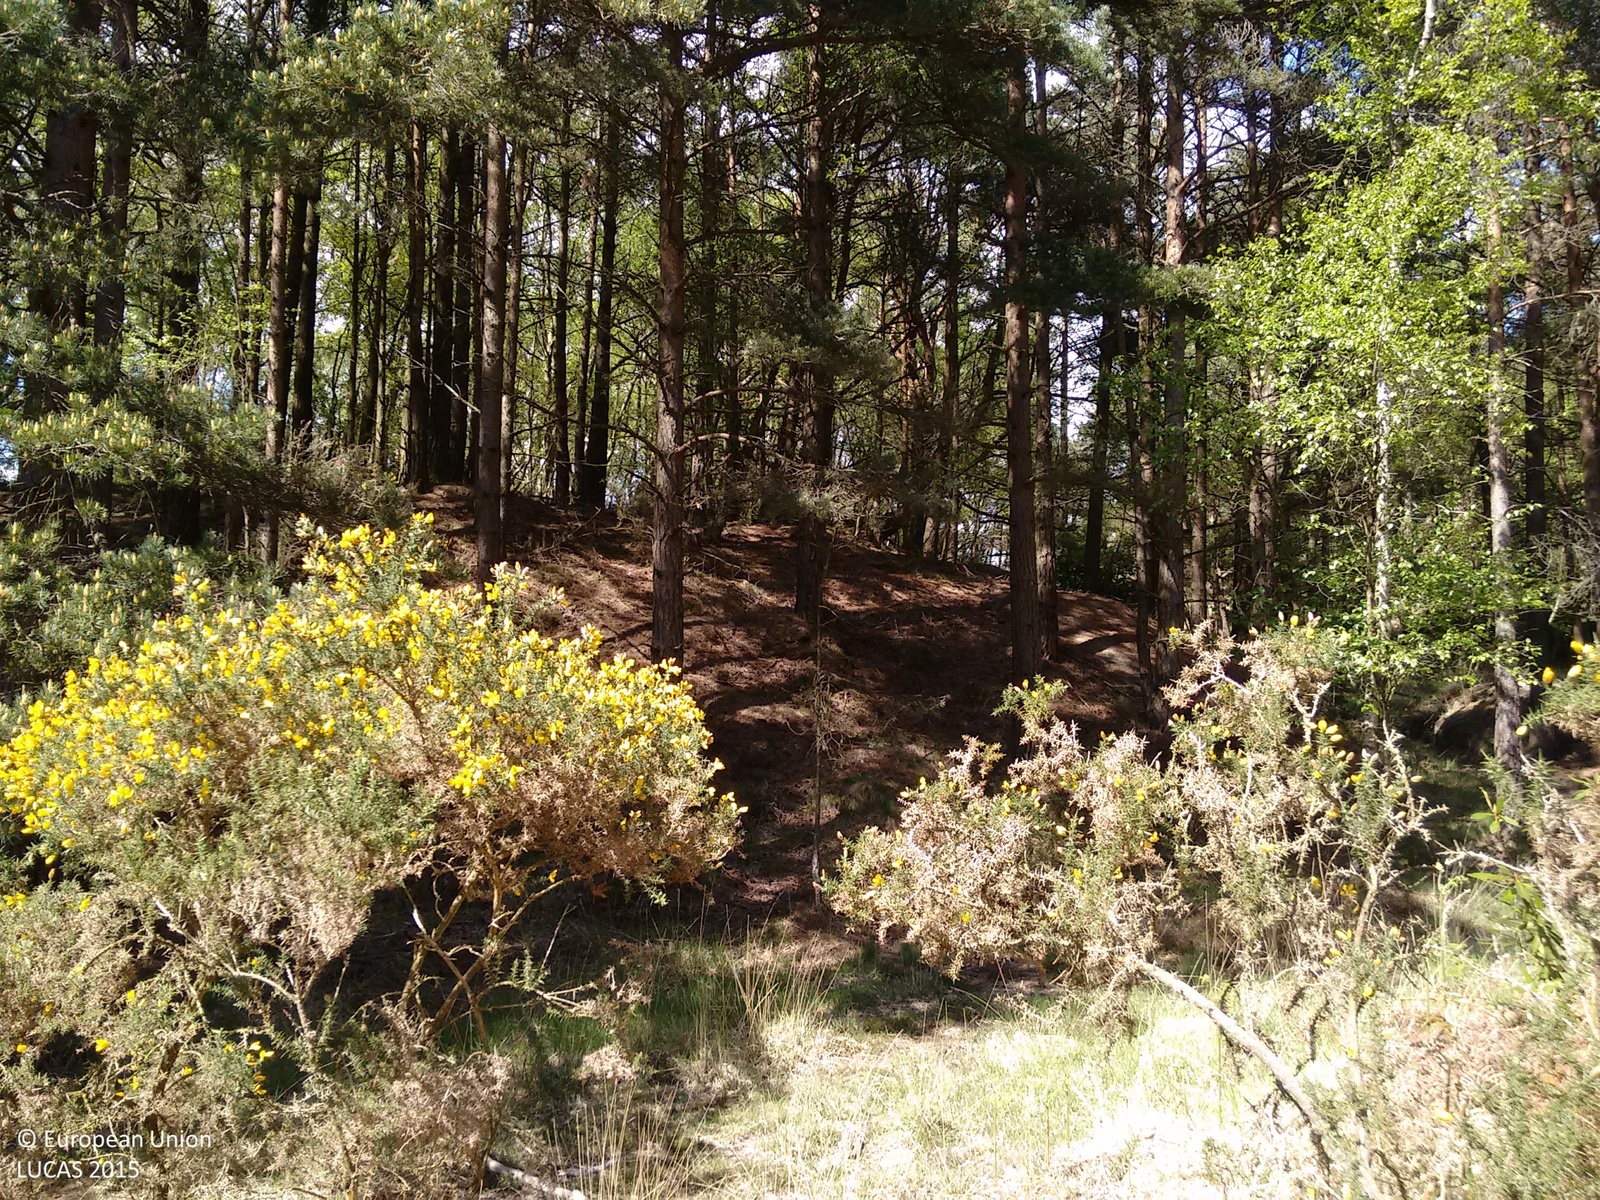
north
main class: Woodland
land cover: Pine dominated mixed woodland
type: hemiboreal forest and nemoral coniferous forest and mixed broadleaved-coniferous forest
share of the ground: > 75 %
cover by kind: coniferous forest trees 70 %, broadleaved forest trees 25 %, shrubs 5 %
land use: Forestry
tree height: > 5 m
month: May
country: GB
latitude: 50.6469
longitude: -2.0947
